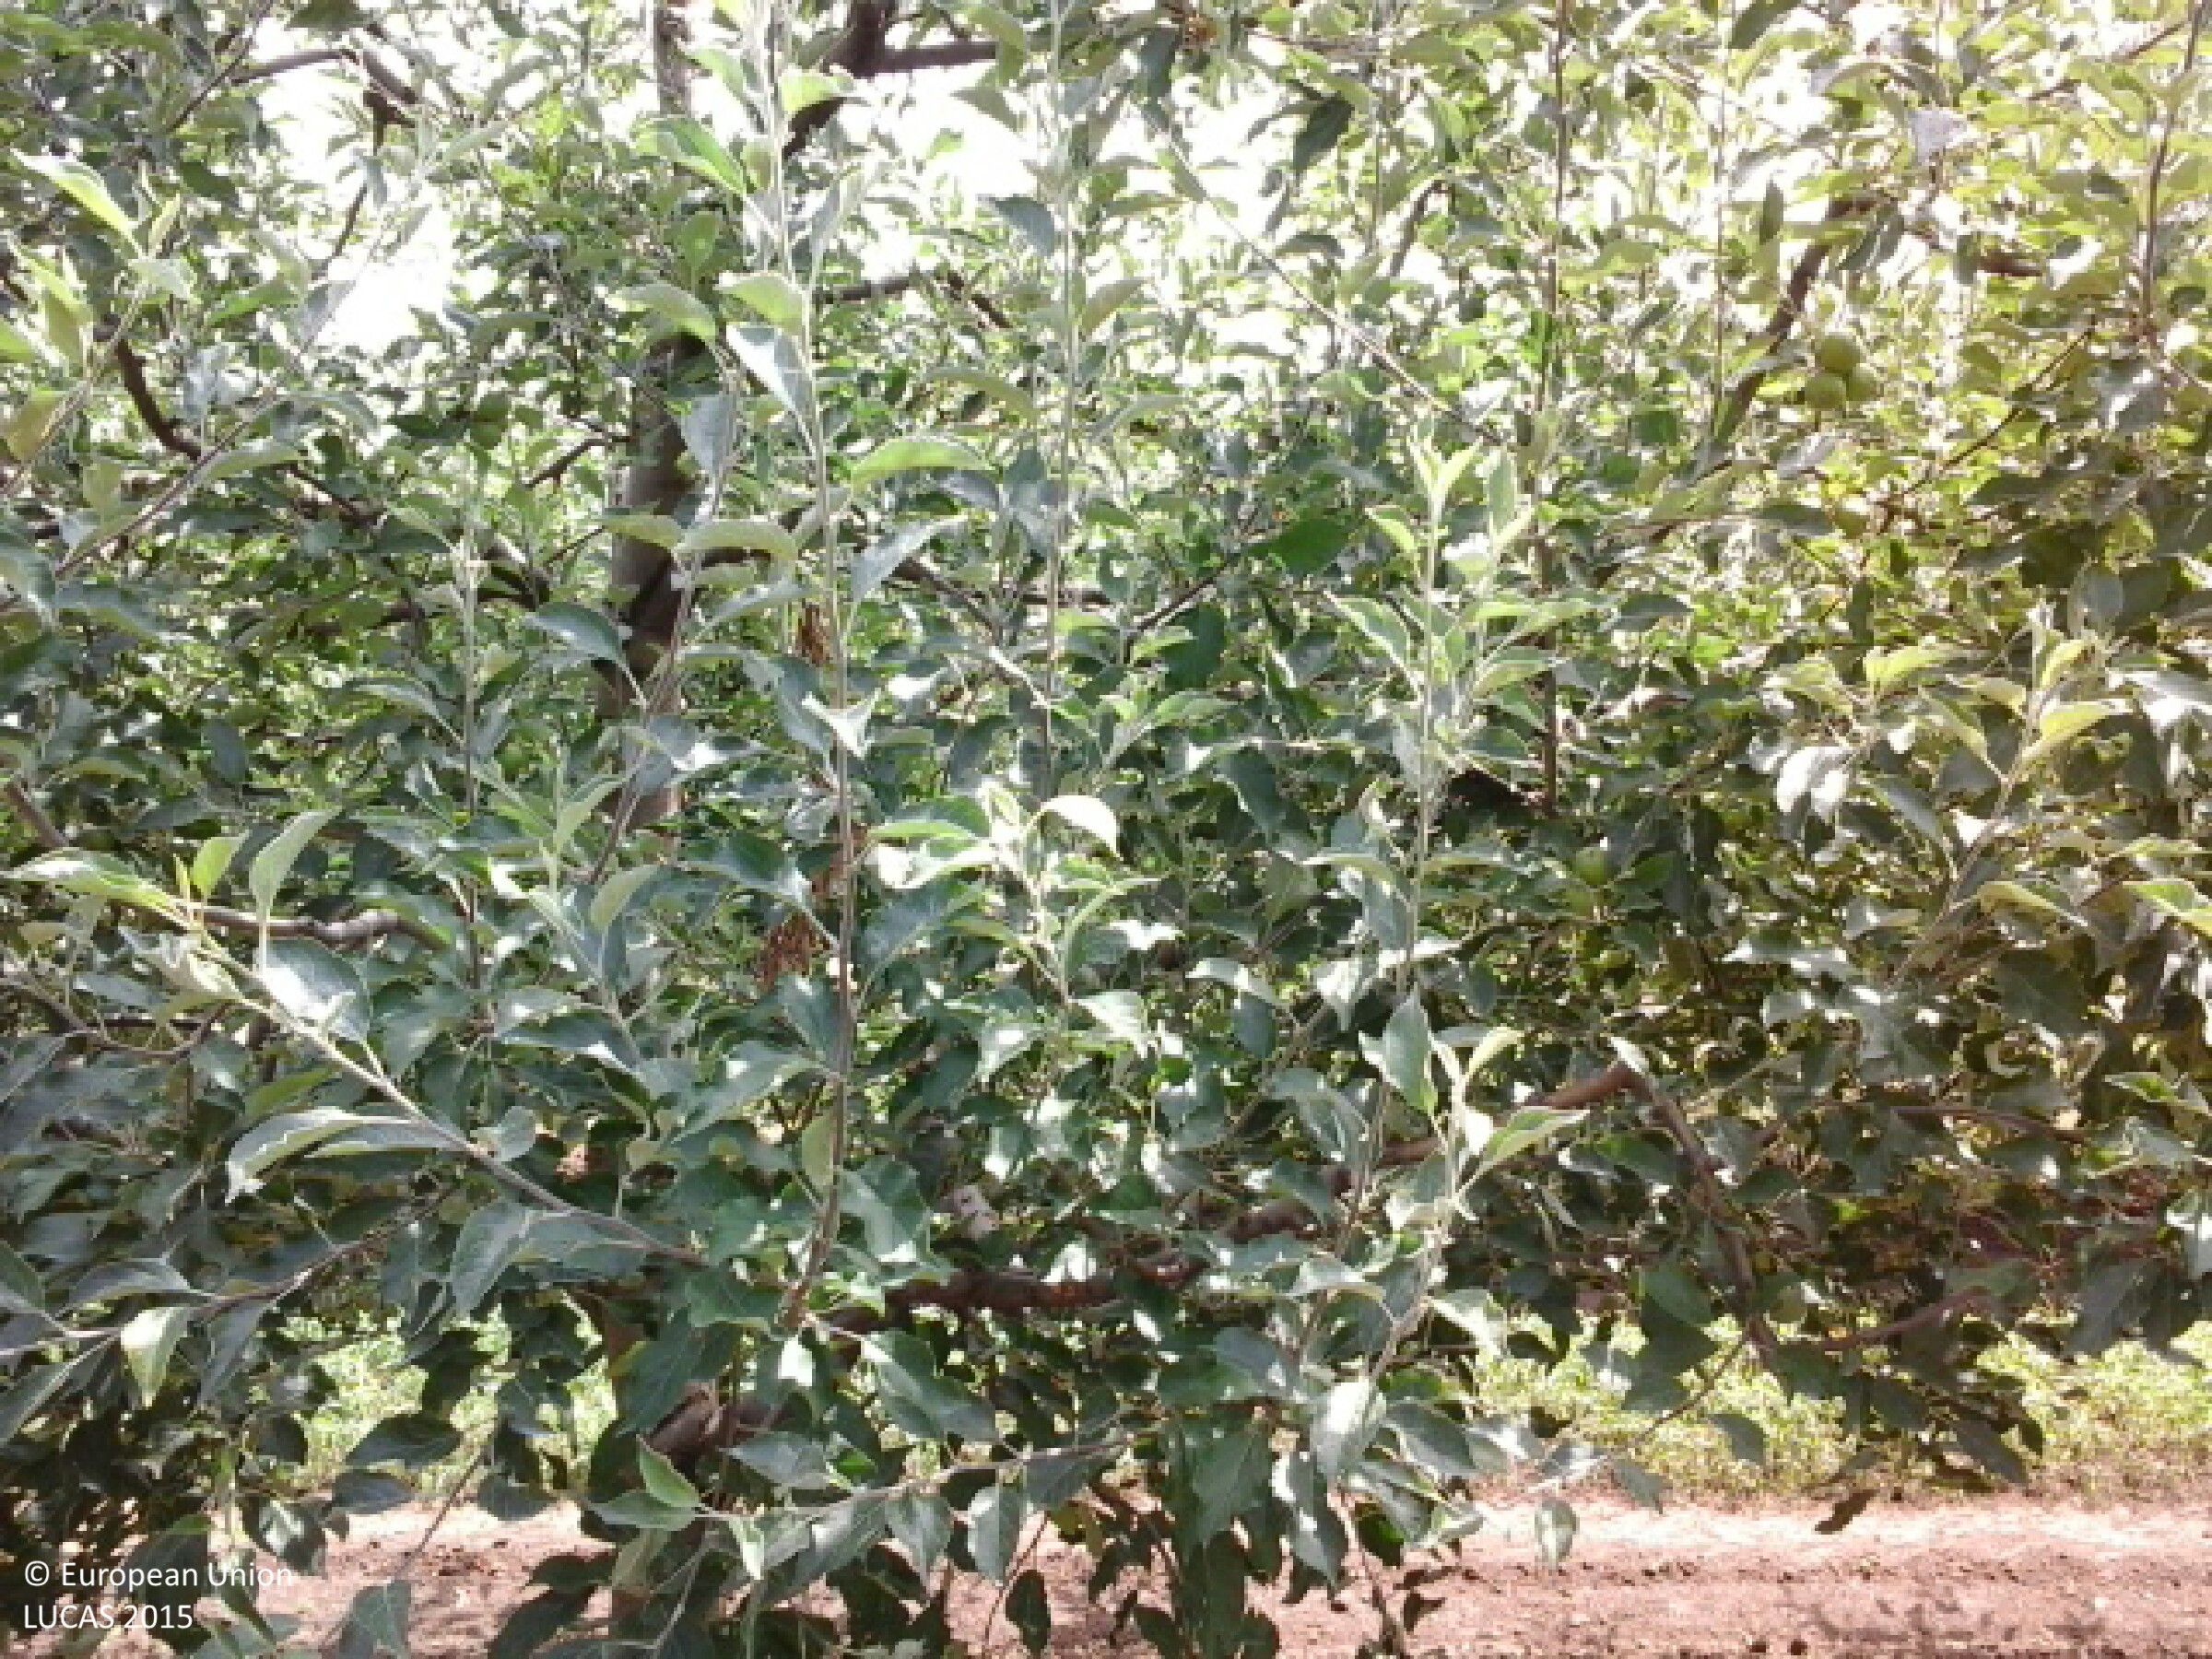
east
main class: Cropland
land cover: Apple fruit
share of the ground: 50 - 75 %
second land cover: Grassland without tree/shrub cover
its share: > 75 %
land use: Agriculture (excluding fallow land and kitchen gardens)
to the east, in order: Apple fruit; Grassland without tree/shrub cover; Fences; Grassland without tree/shrub cover
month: June
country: HU
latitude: 47.8390
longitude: 21.6574
